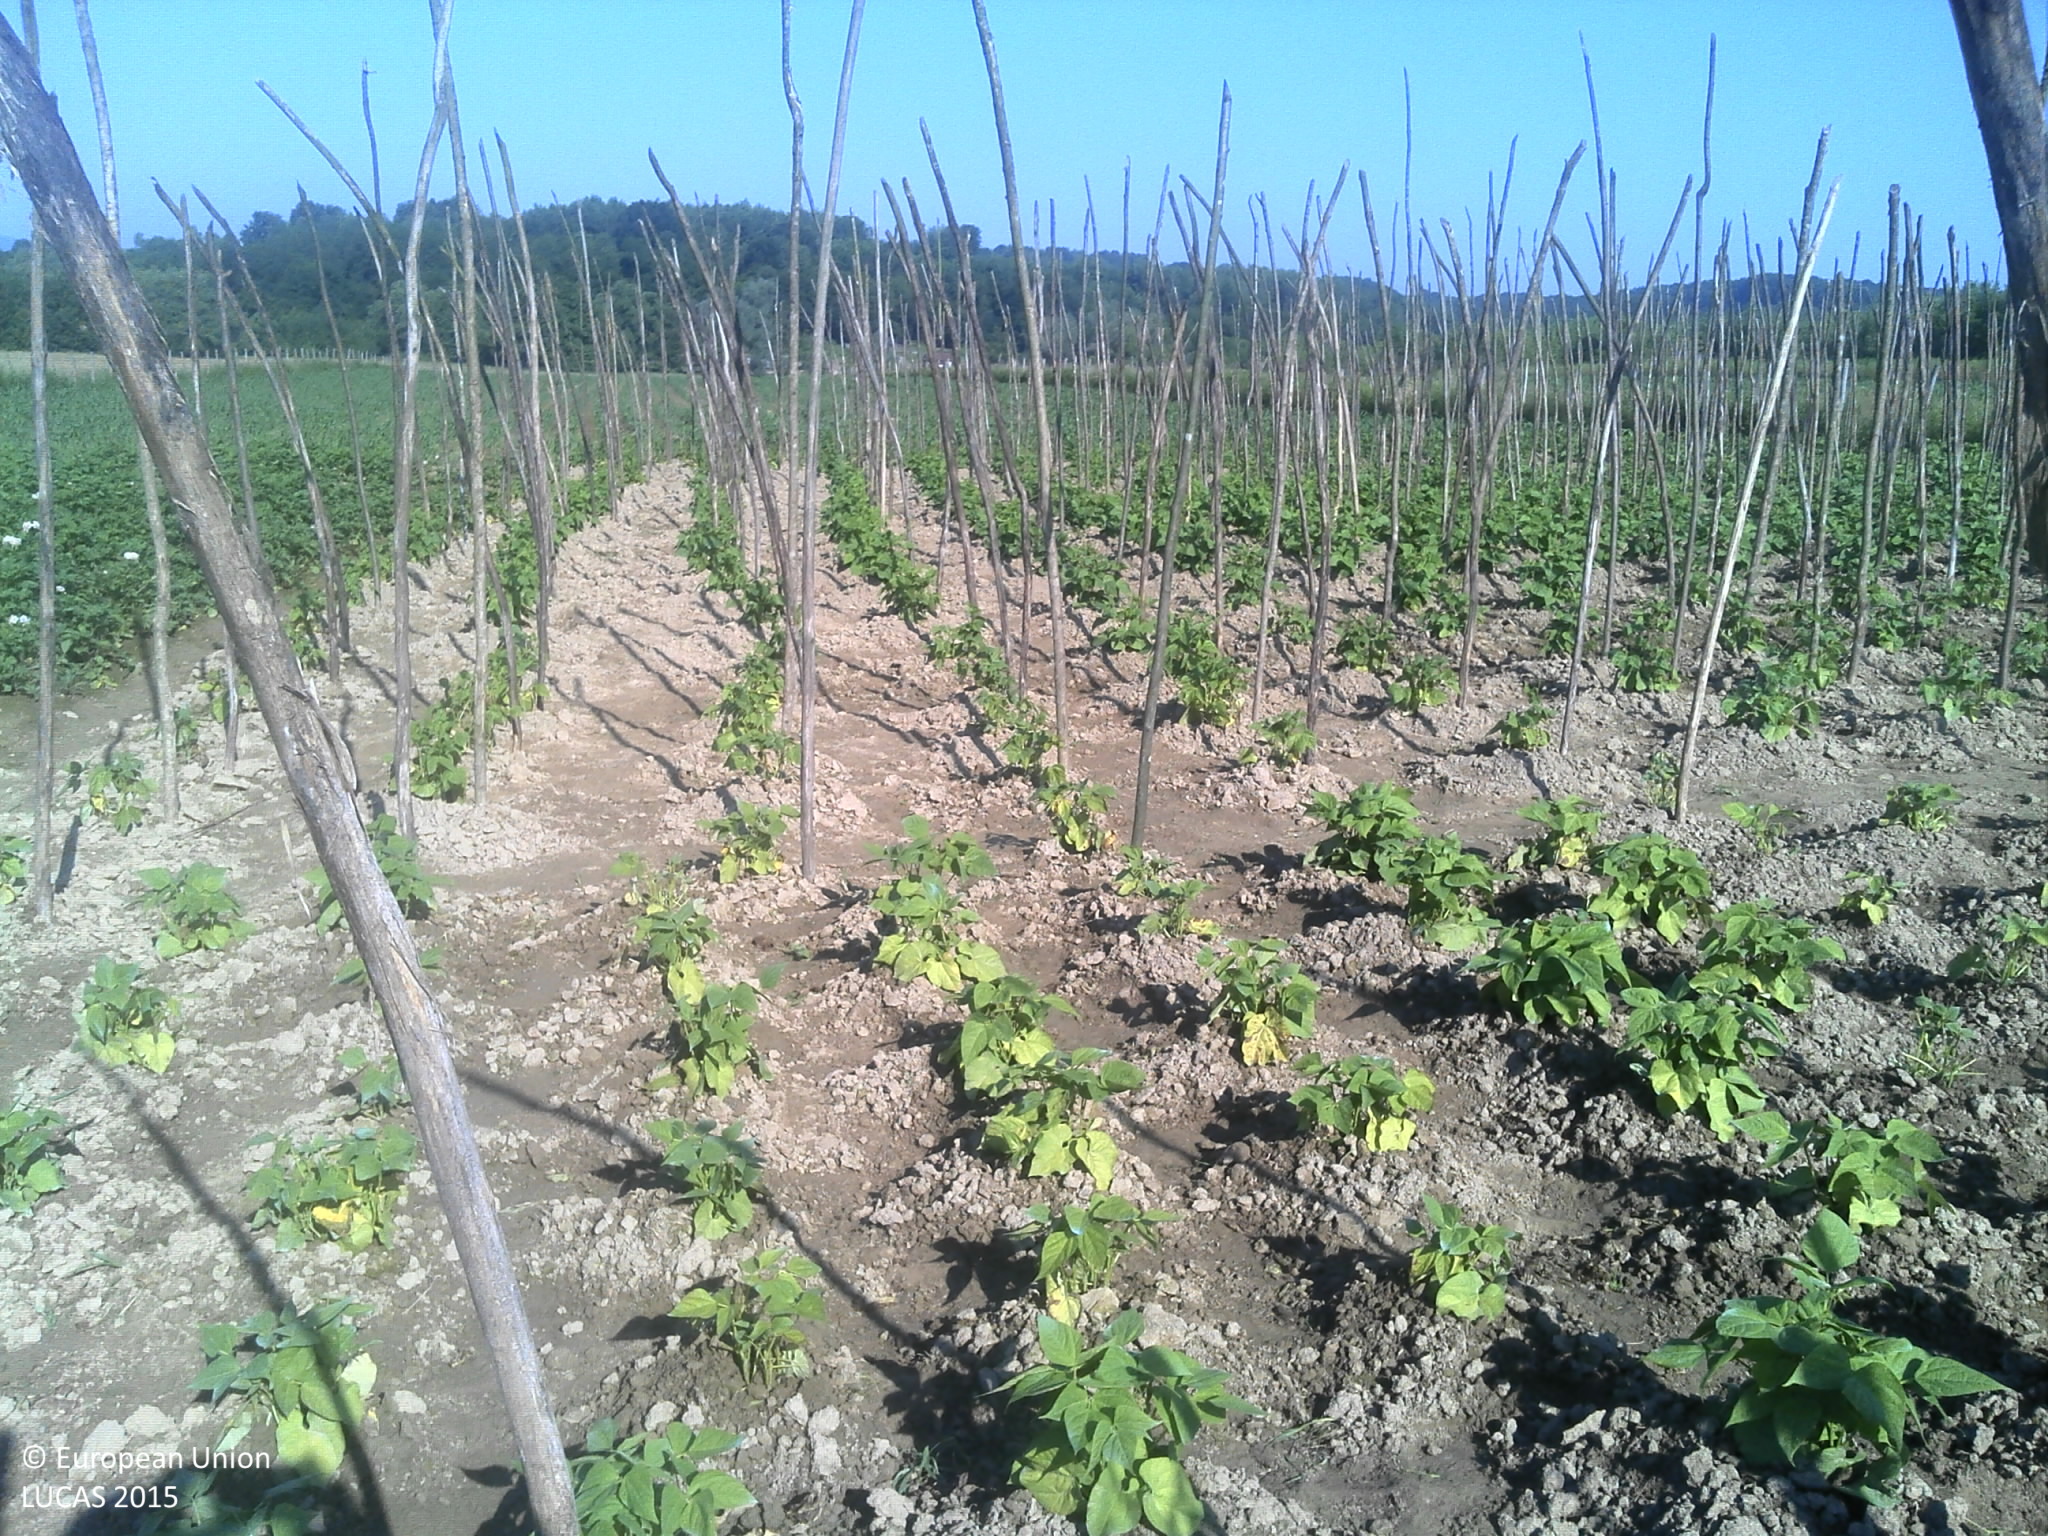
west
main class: Cropland
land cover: Other fresh vegetables
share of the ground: 50 - 75 %
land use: Kitchen garden
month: June
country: HR
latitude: 45.6222
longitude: 17.6852
